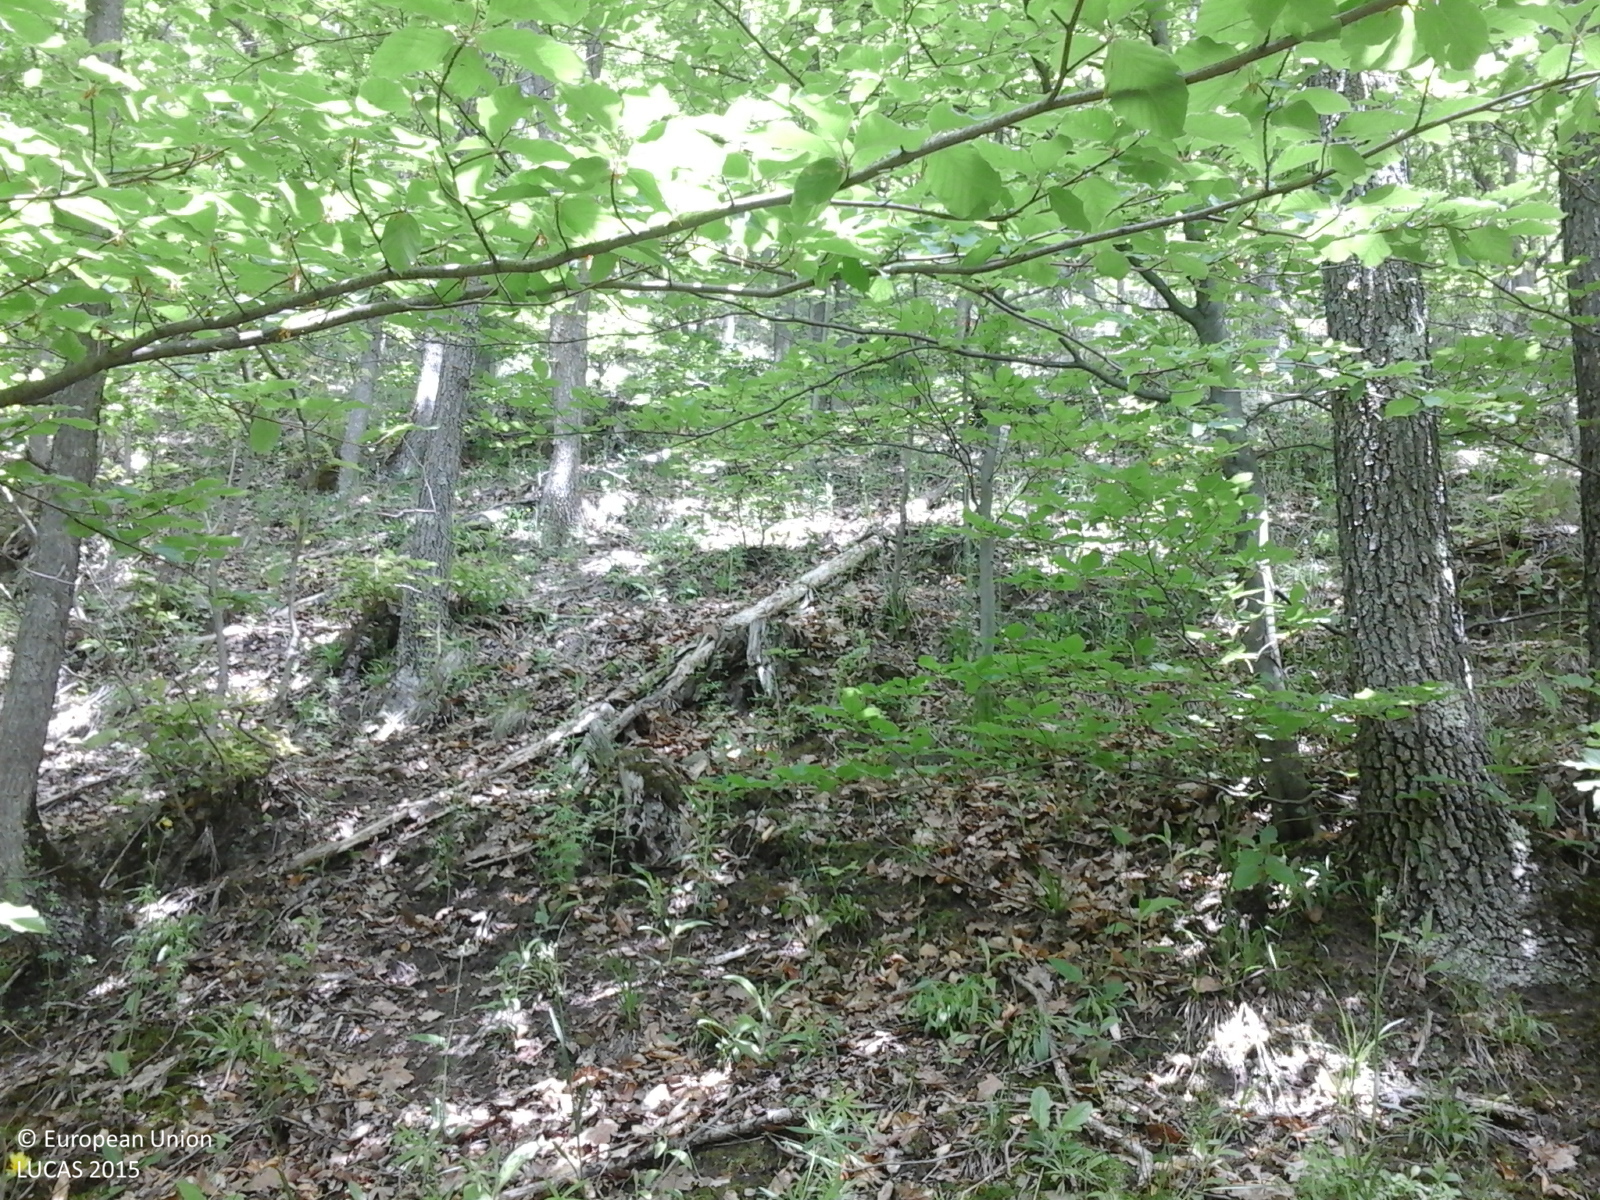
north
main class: Woodland
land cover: Broadleaved woodland
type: acidophilous oak and oak-birch forest
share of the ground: > 75 %
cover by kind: broadleaved forest trees 100 %
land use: Forestry
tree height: > 5 m
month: May
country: RO
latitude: 45.7617
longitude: 25.9937
